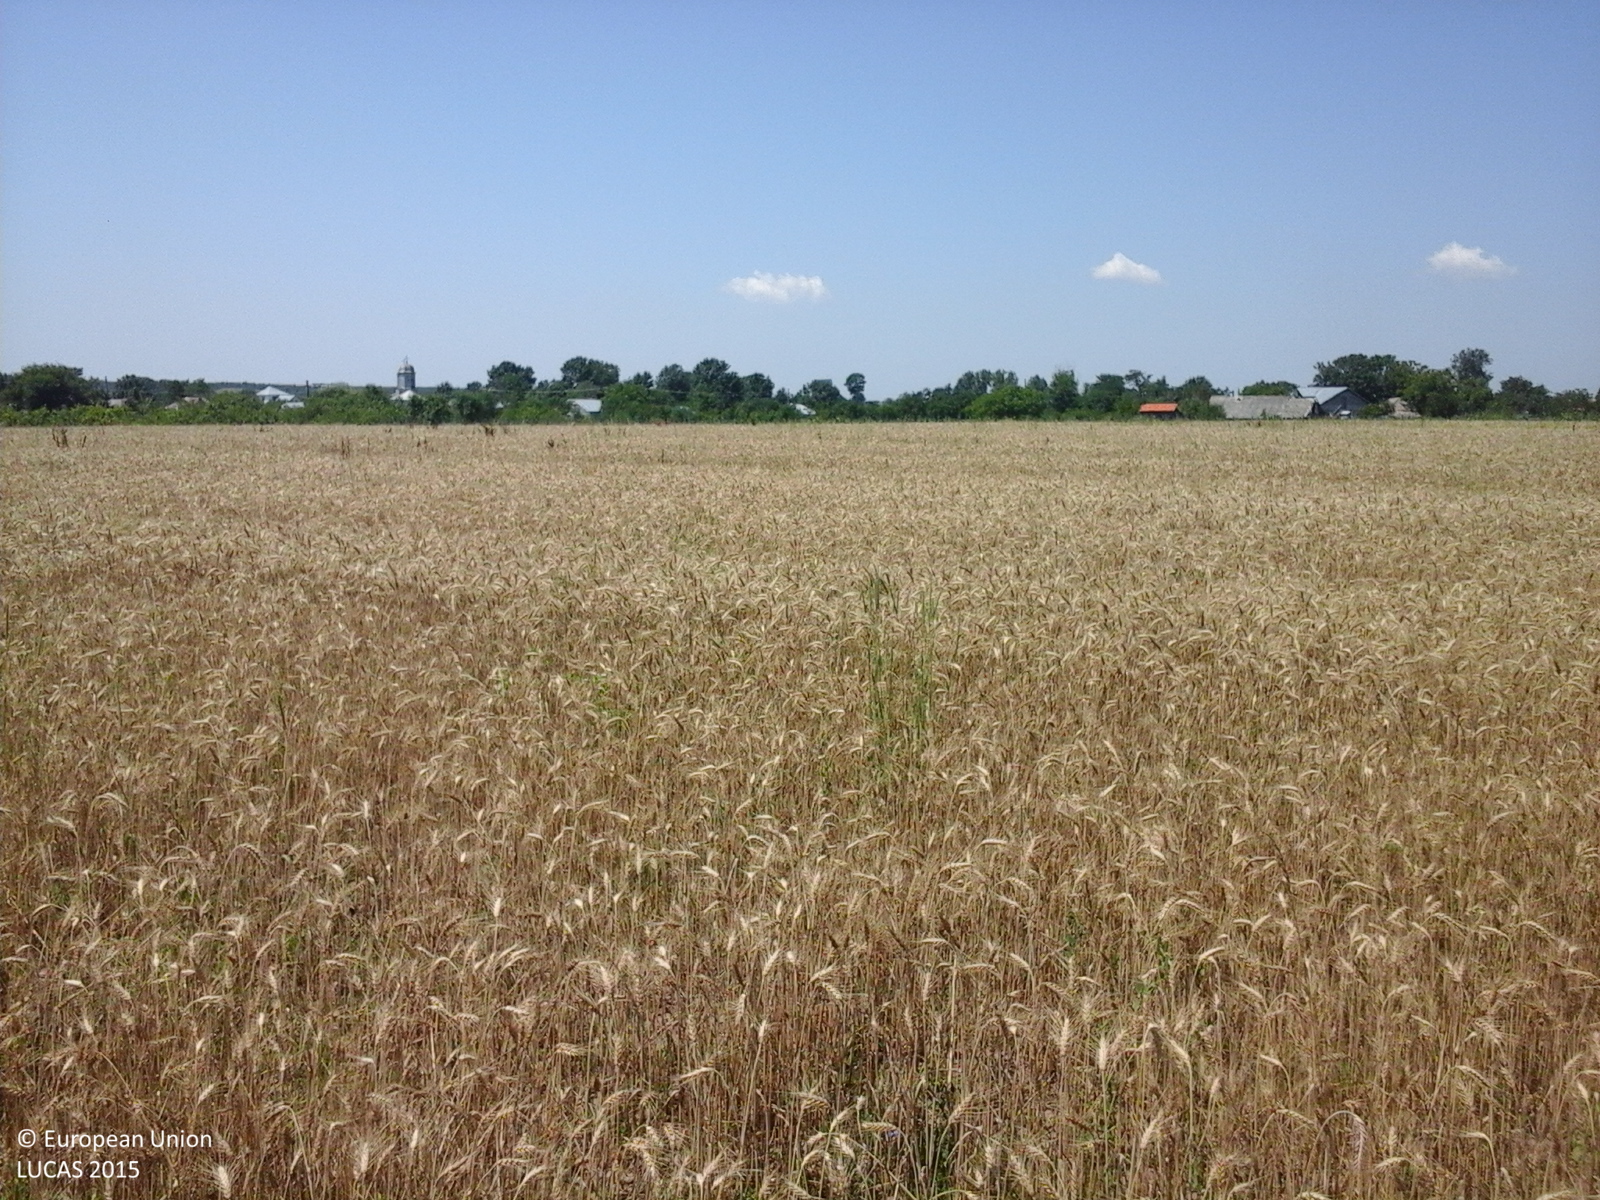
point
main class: Cropland
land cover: Common wheat
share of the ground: > 75 %
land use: Agriculture (excluding fallow land and kitchen gardens)
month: July
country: RO
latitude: 44.4765
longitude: 24.6445
